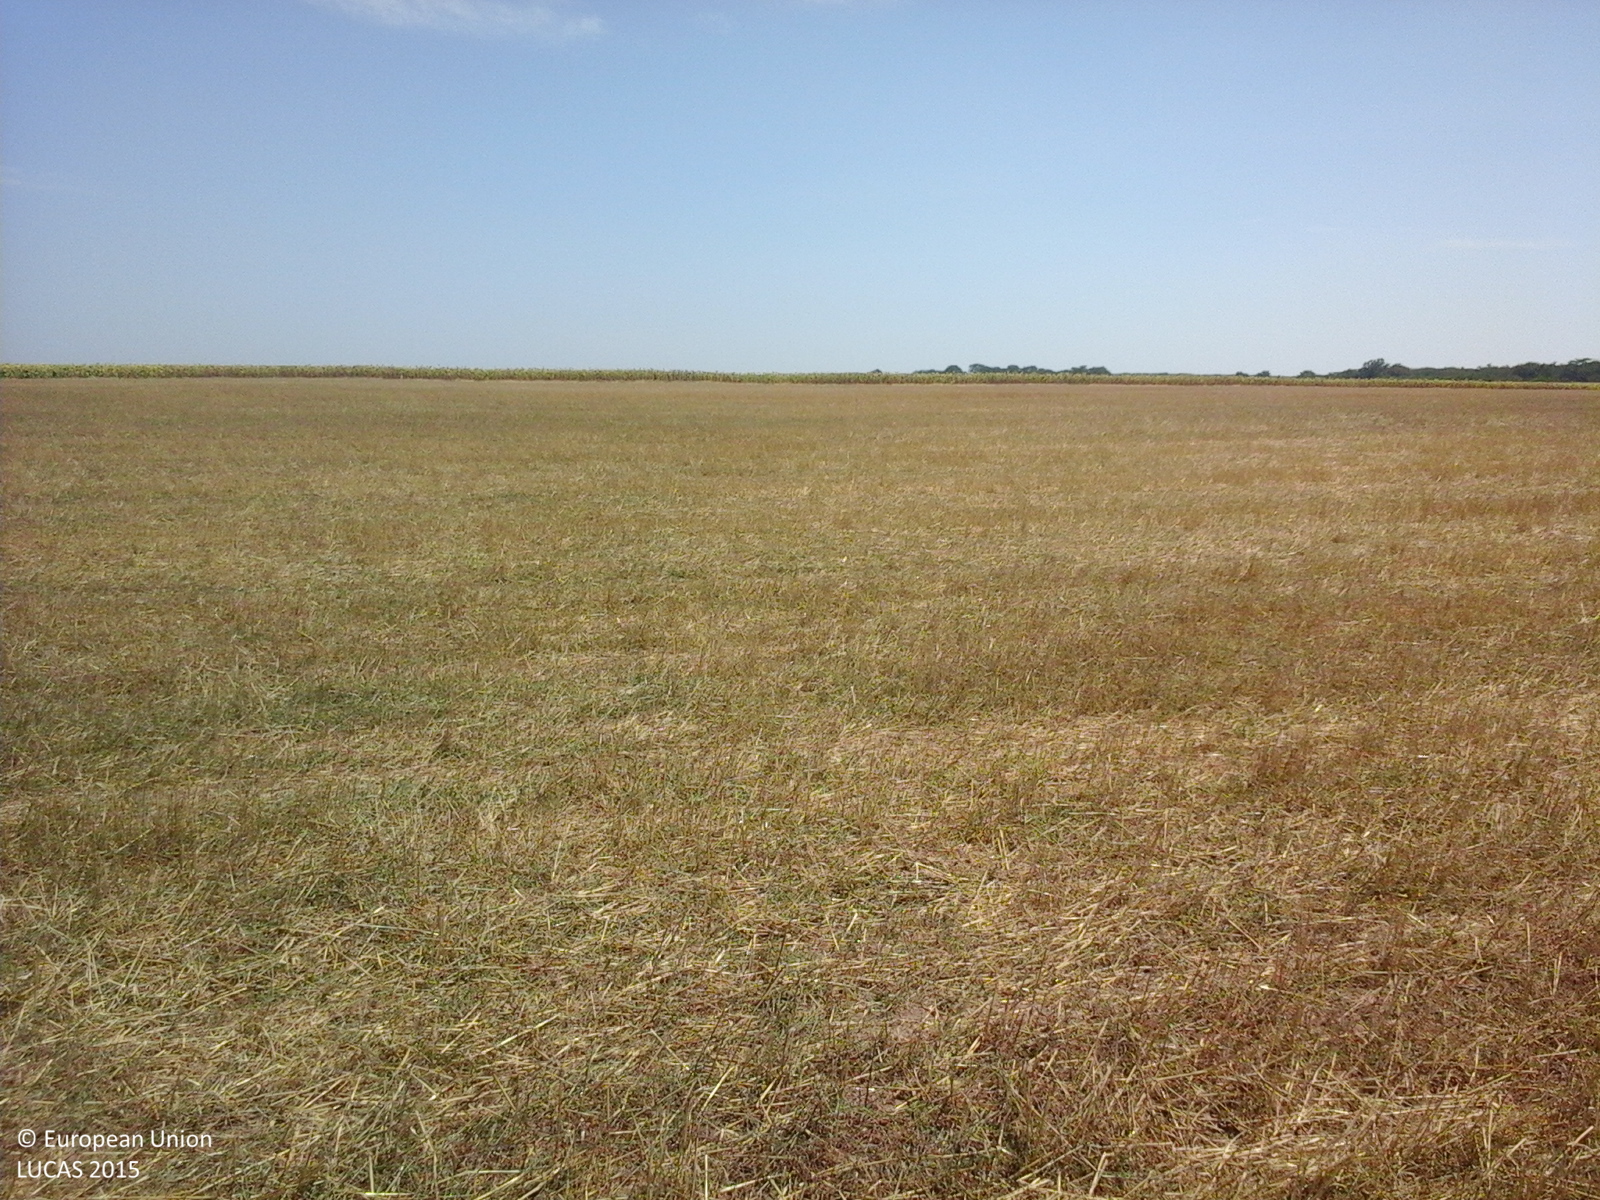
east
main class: Cropland
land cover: Barley
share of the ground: > 75 %
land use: Agriculture (excluding fallow land and kitchen gardens)
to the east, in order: Barley; Sunflower
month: August
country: RO
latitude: 45.7552
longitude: 27.5250
